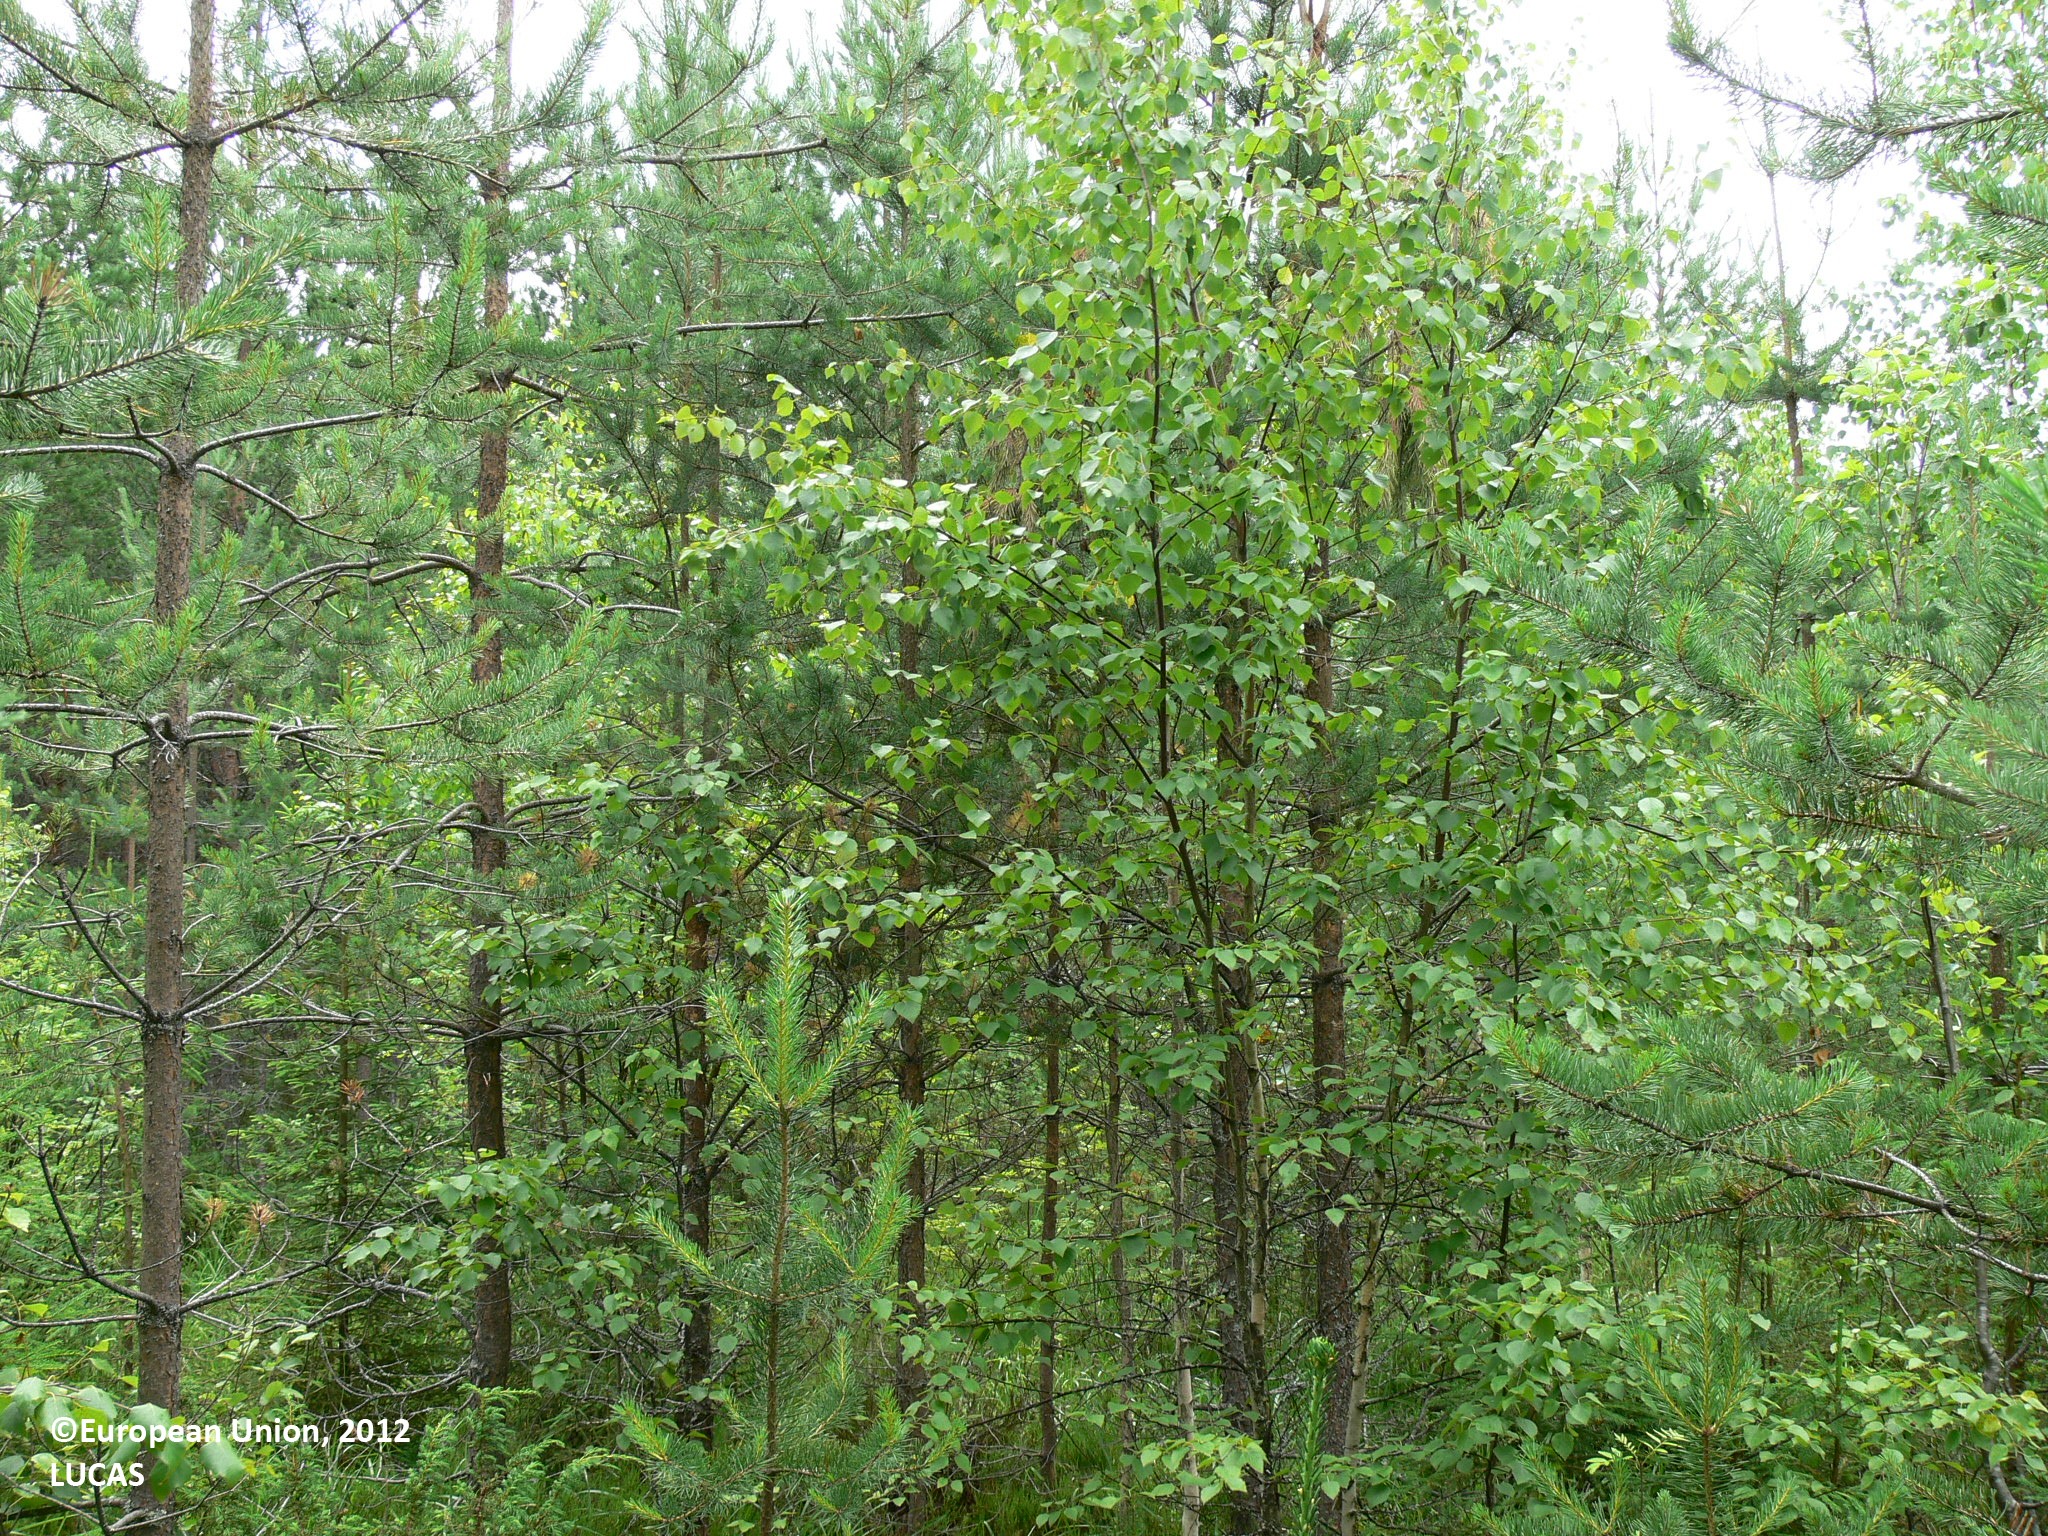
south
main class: Woodland
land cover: Pine dominated mixed woodland
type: boreal forest
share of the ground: > 75 %
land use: Forestry
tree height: > 5 m
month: July
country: FI
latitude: 63.0011
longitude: 29.4837
